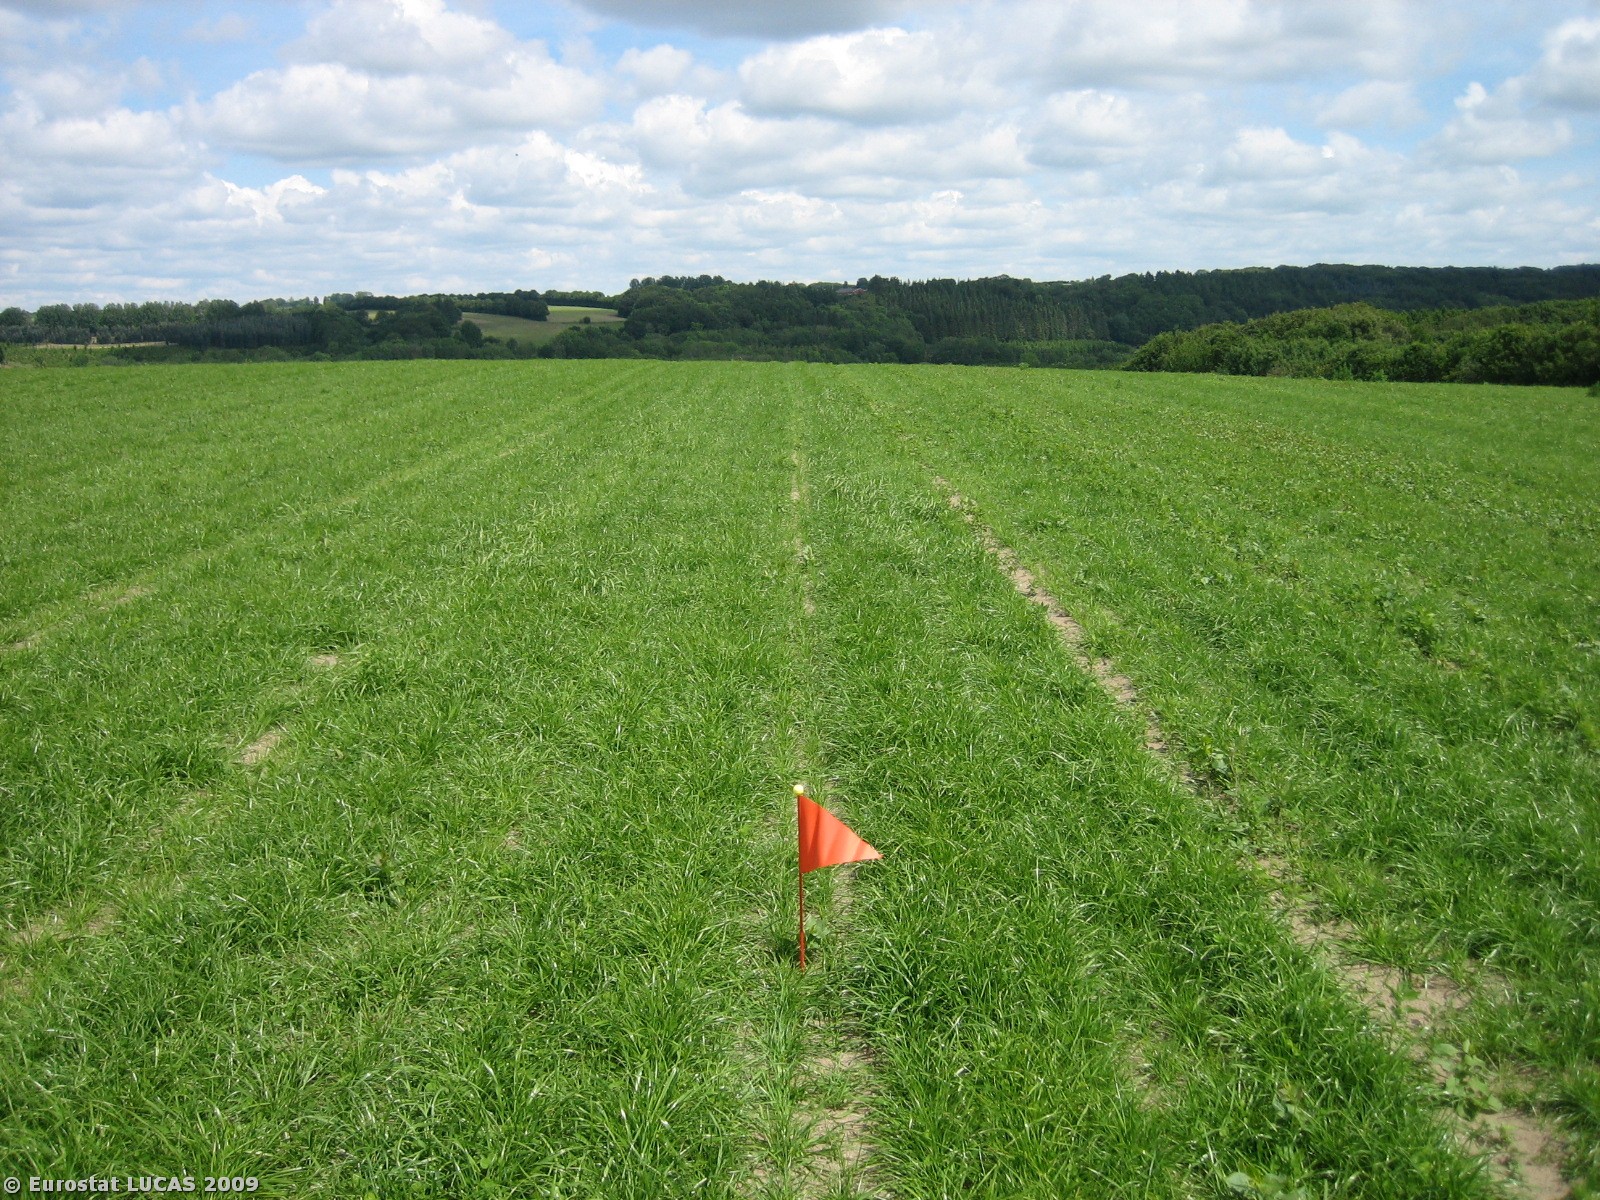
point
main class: Cropland
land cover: Temporary grasslands
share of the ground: 50 - 75 %
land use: Agriculture (excluding fallow land and kitchen gardens)
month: June
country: DK
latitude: 56.0617
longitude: 9.7915
